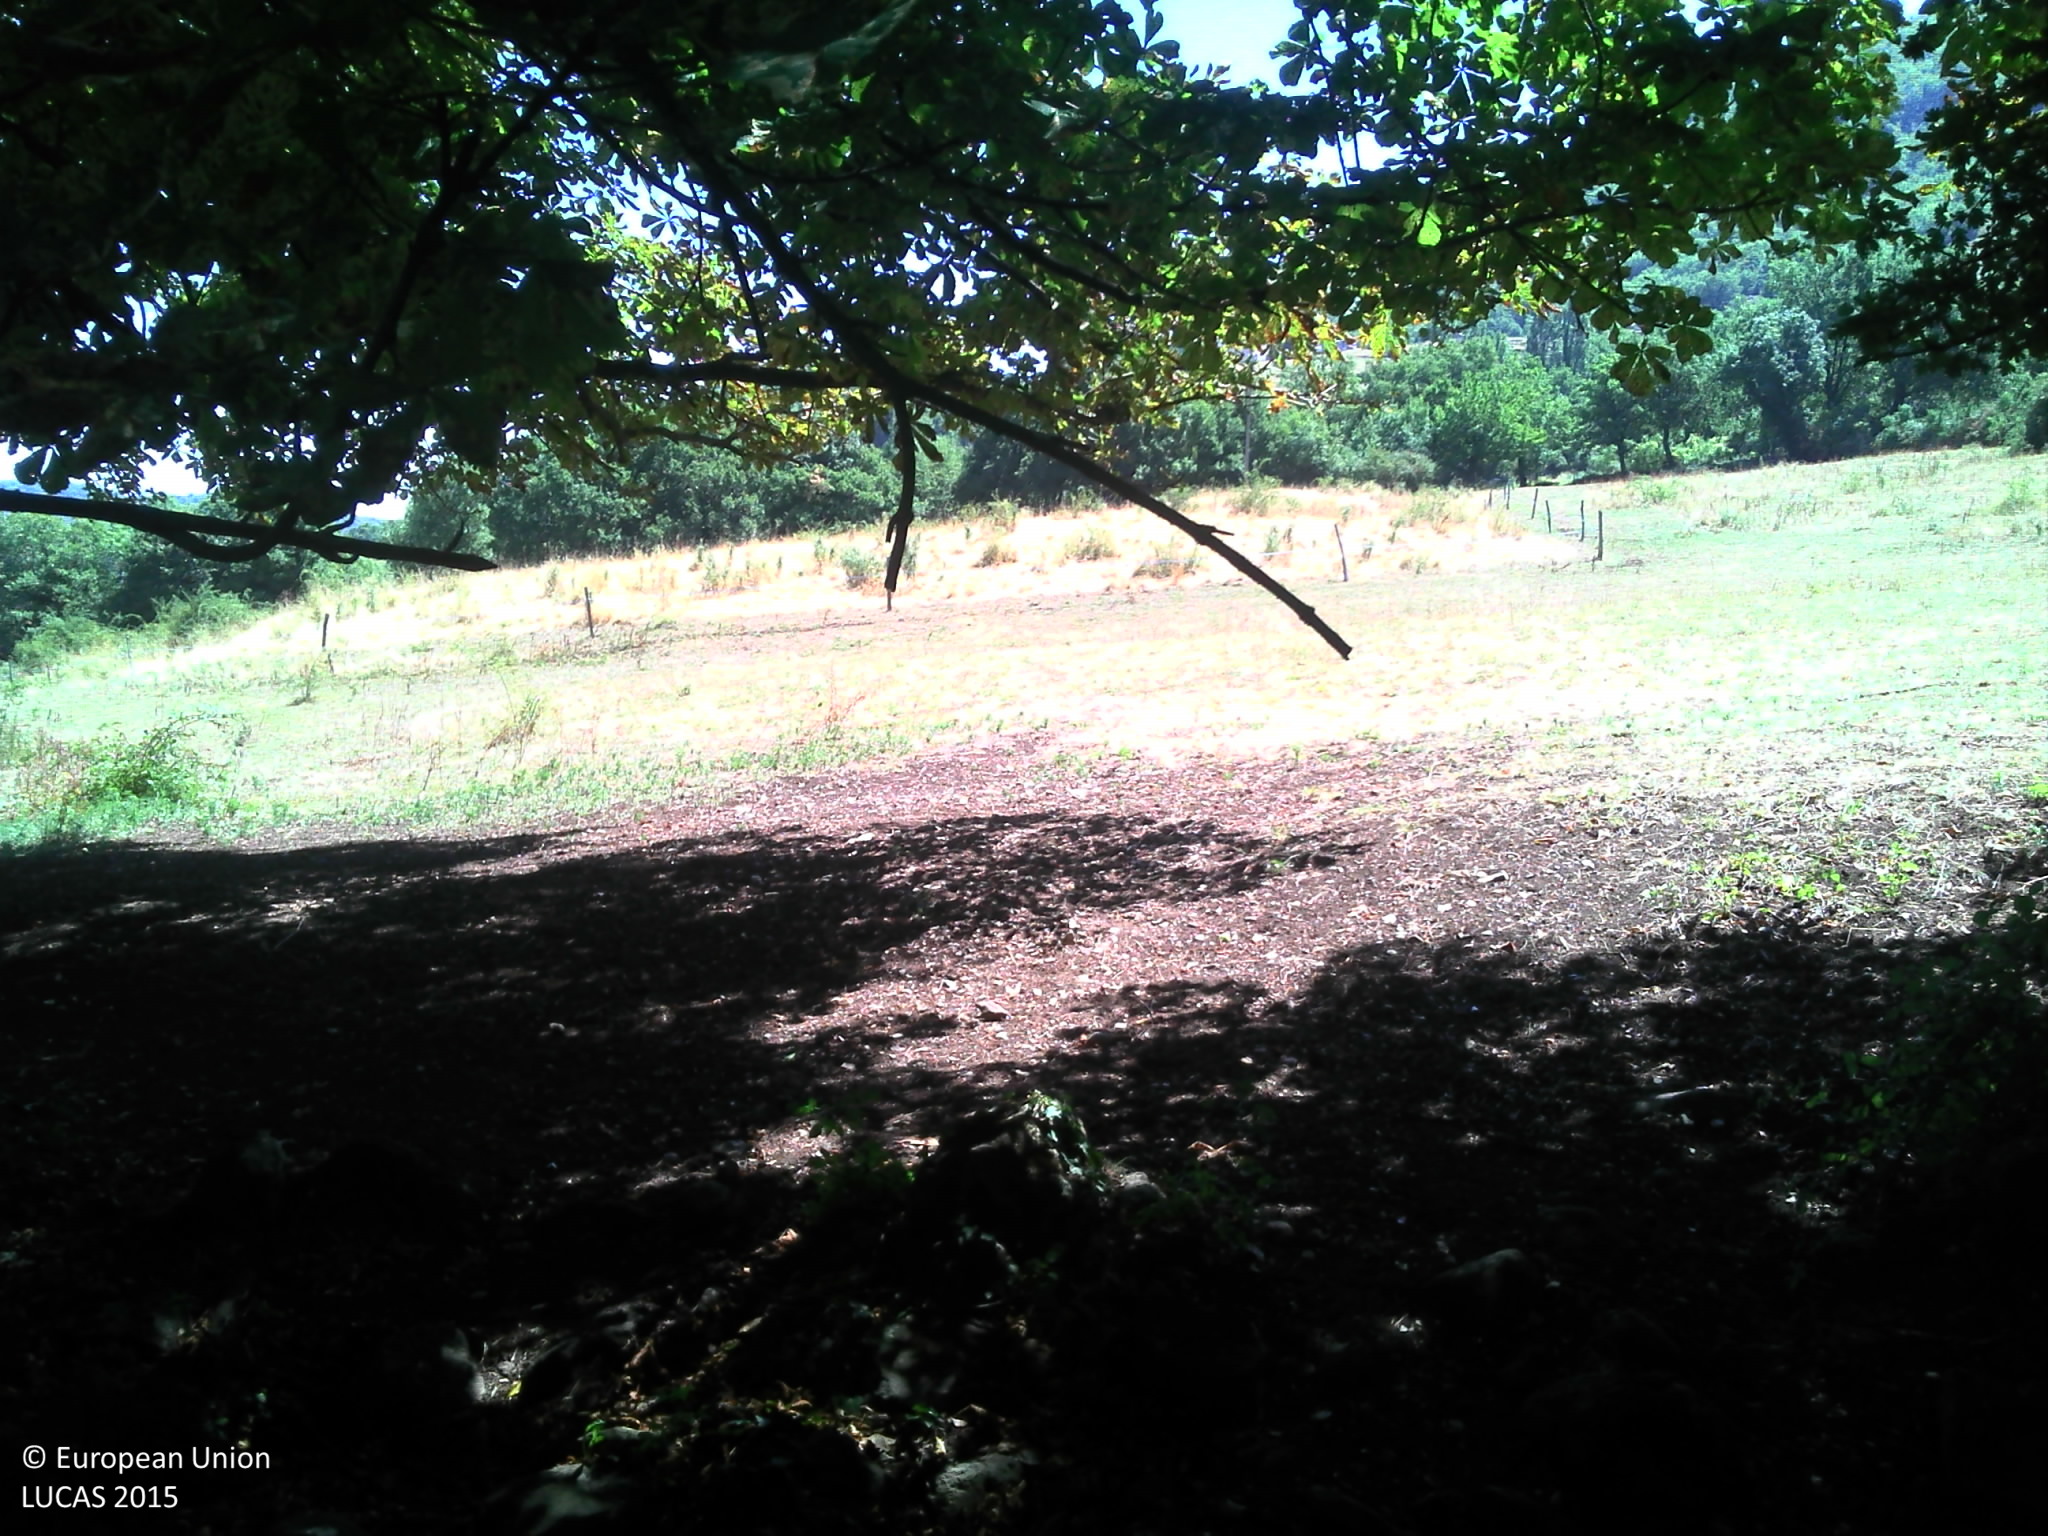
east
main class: Grassland
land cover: Grassland without tree/shrub cover
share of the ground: > 75 %
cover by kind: herbaceous plants 100 %
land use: Agriculture (excluding fallow land and kitchen gardens)
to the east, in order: Grassland without tree/shrub cover; Fences; Grassland with sparse tree/shrub cover; Lines of trees; Grassland without tree/shrub cover; Paved roads, cycling and walking lanes; Dry stone walls; Grassland without tree/shrub cover; Lines of trees; Grassland without tree/shrub cover
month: July
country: FR
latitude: 44.7154
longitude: 4.5906
